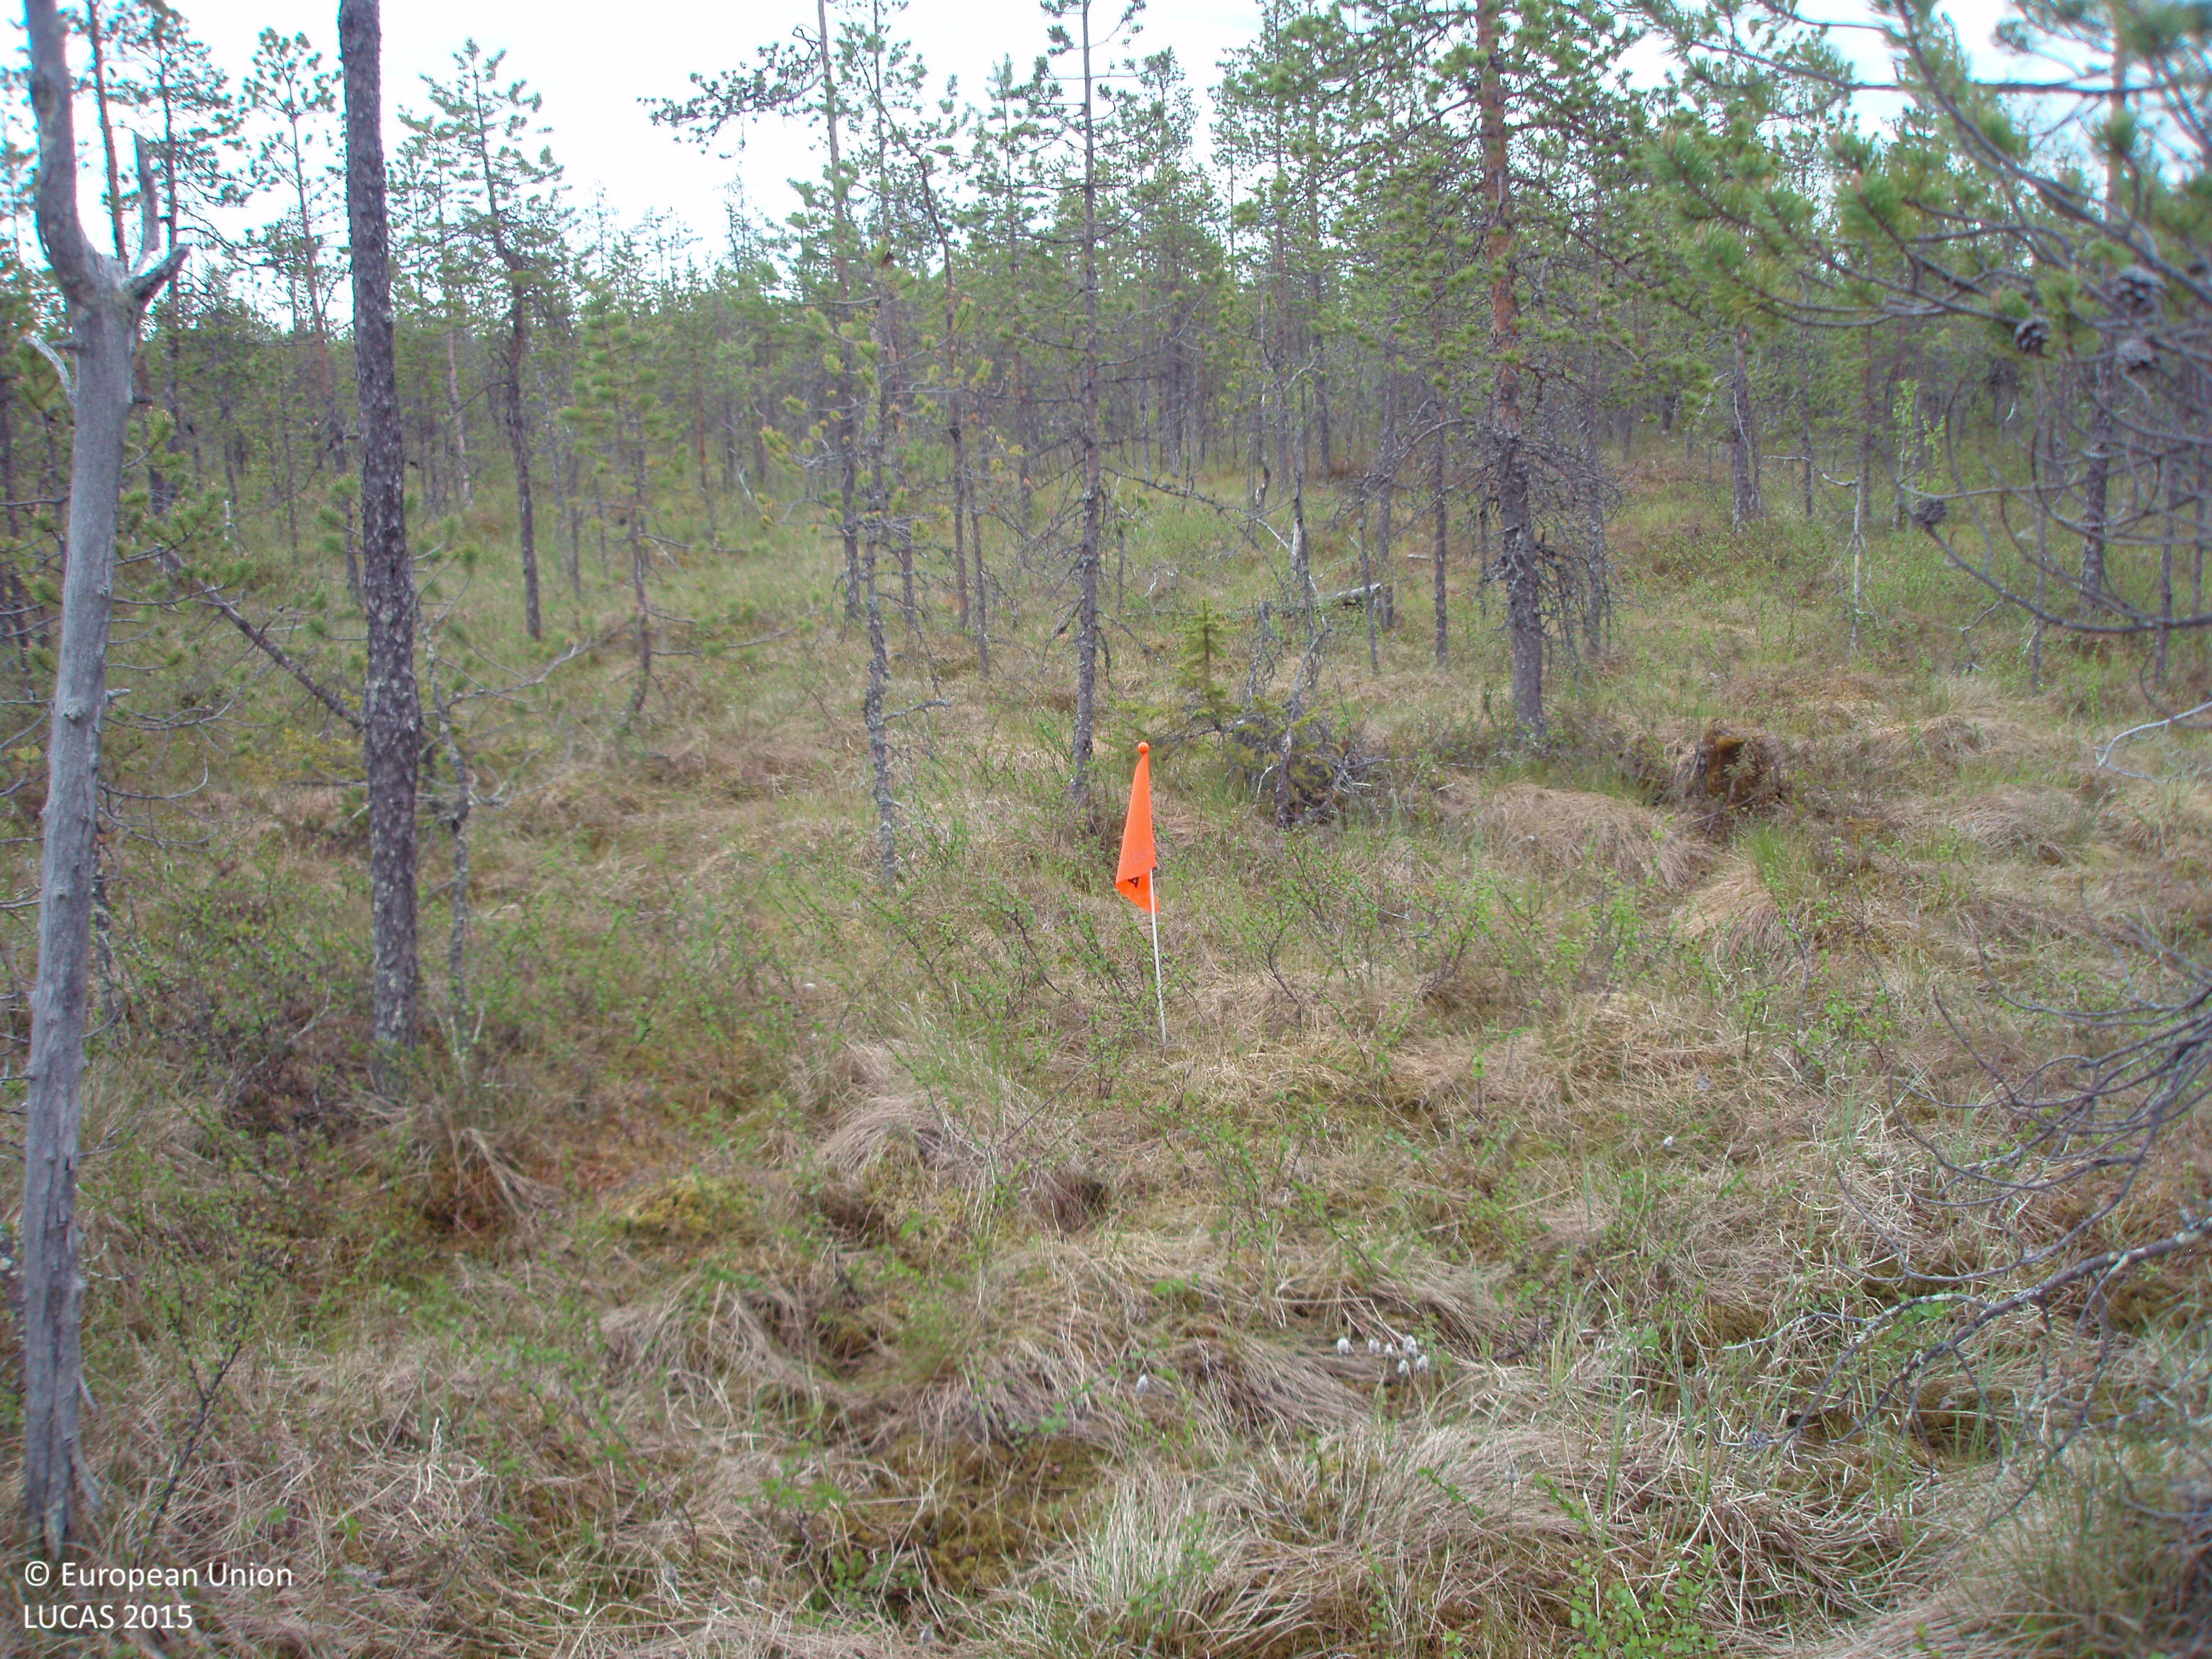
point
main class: Woodland
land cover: Pine dominated coniferous woodland
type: boreal forest
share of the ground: 10 - 25 %
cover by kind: shrubs 50 %, herbaceous plants 30 %, coniferous forest trees 20 %
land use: Semi-natural and natural areas not in use
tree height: > 5 m
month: June
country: FI
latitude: 67.2370
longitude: 27.3048
